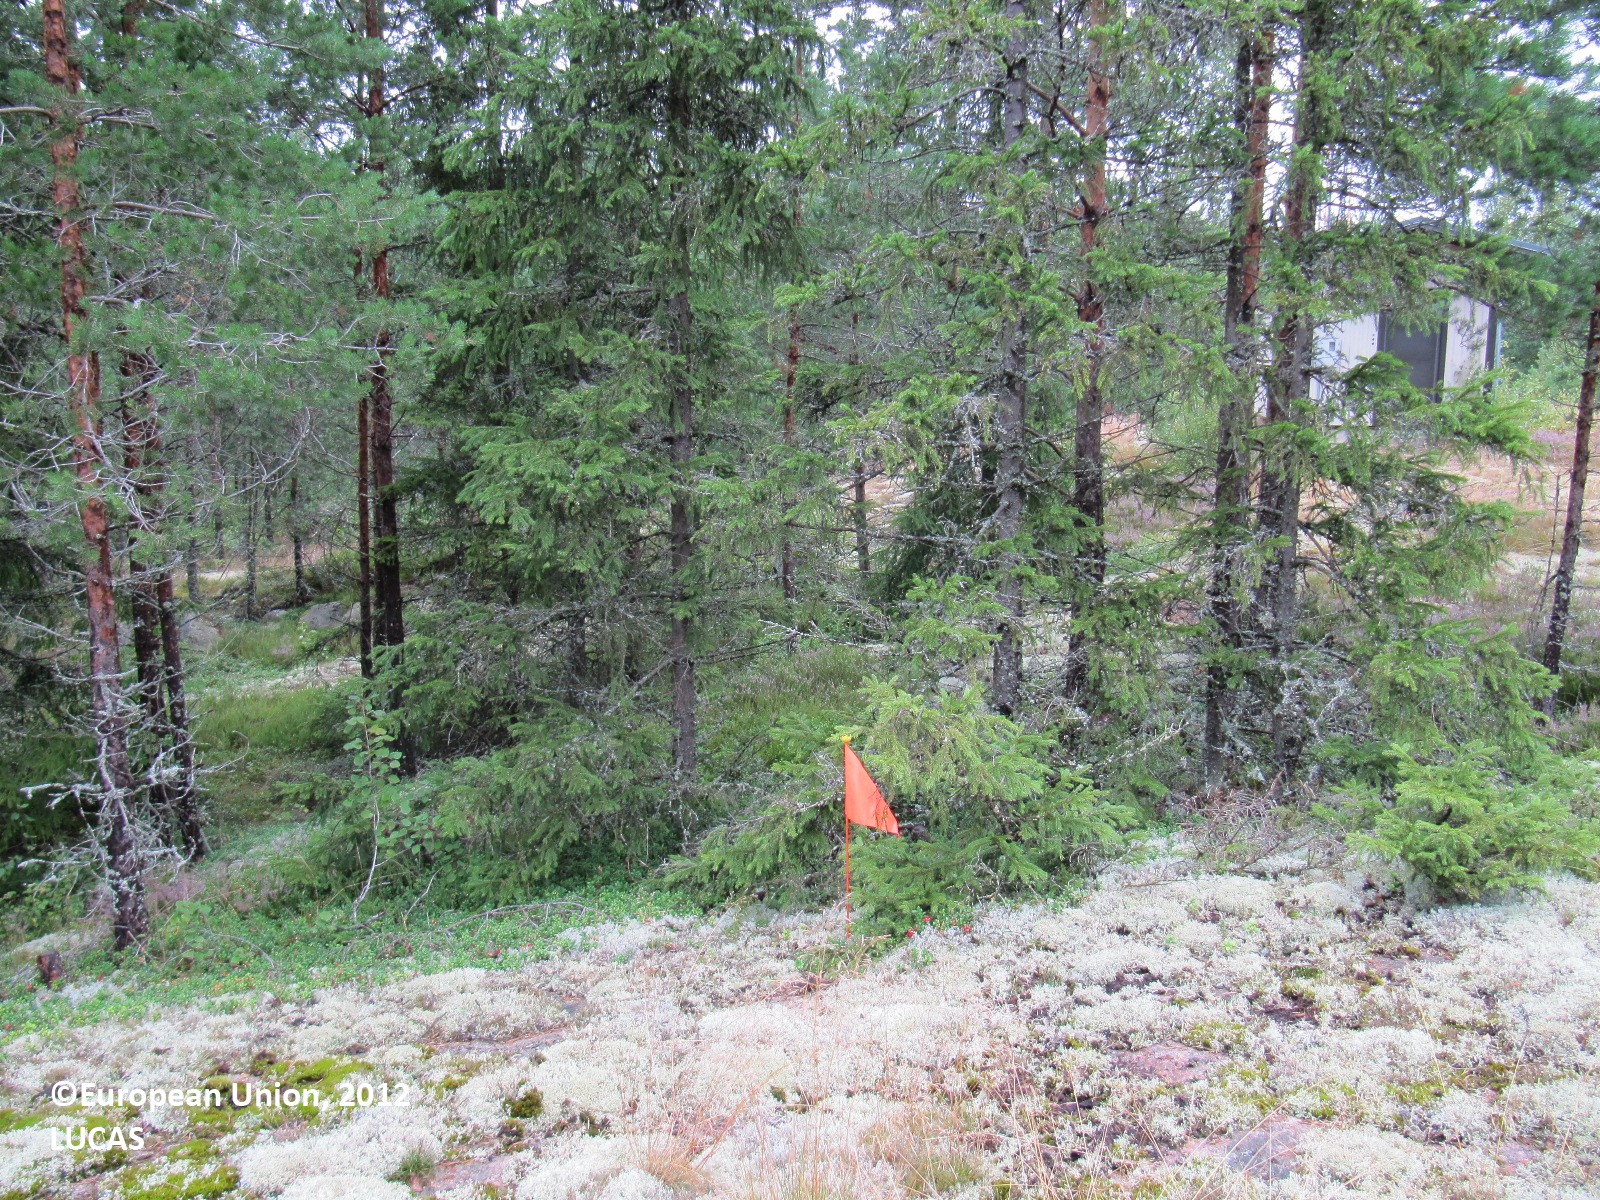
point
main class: Woodland
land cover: Pine dominated coniferous woodland
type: boreal forest
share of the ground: 50 - 75 %
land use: Forestry
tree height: > 5 m
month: August
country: FI
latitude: 60.2843
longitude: 23.0476
